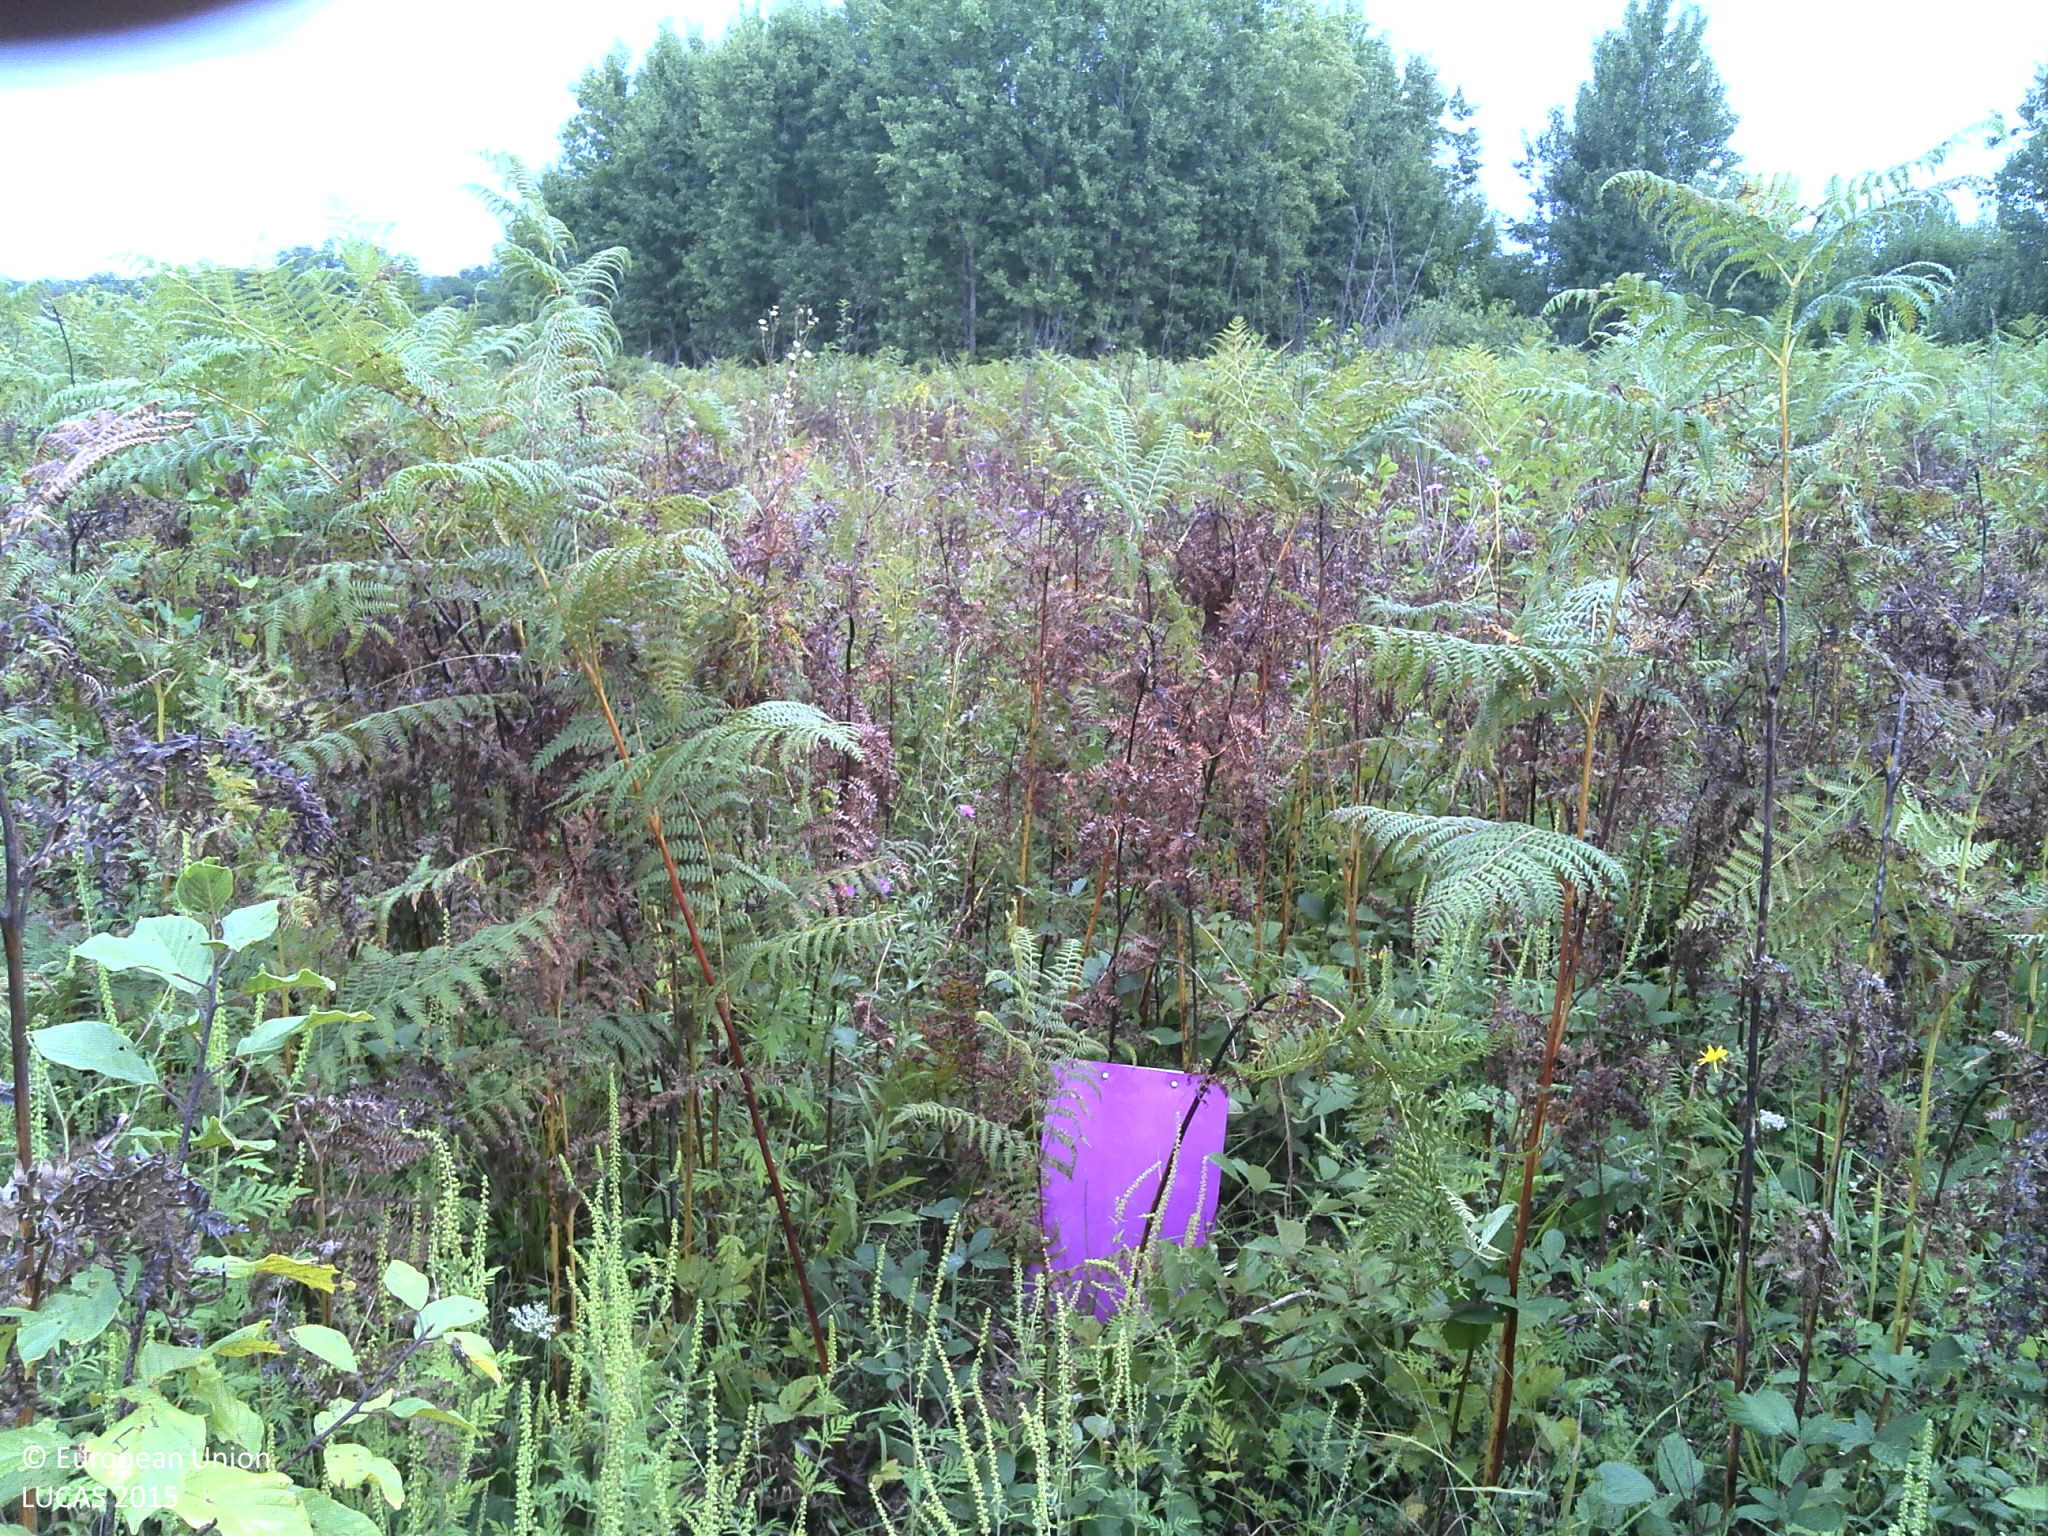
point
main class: Grassland
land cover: Spontaneously vegetated surfaces
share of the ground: > 75 %
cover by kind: herbaceous plants 100 %
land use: Semi-natural and natural areas not in use
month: August
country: HR
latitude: 45.2886
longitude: 16.1550
